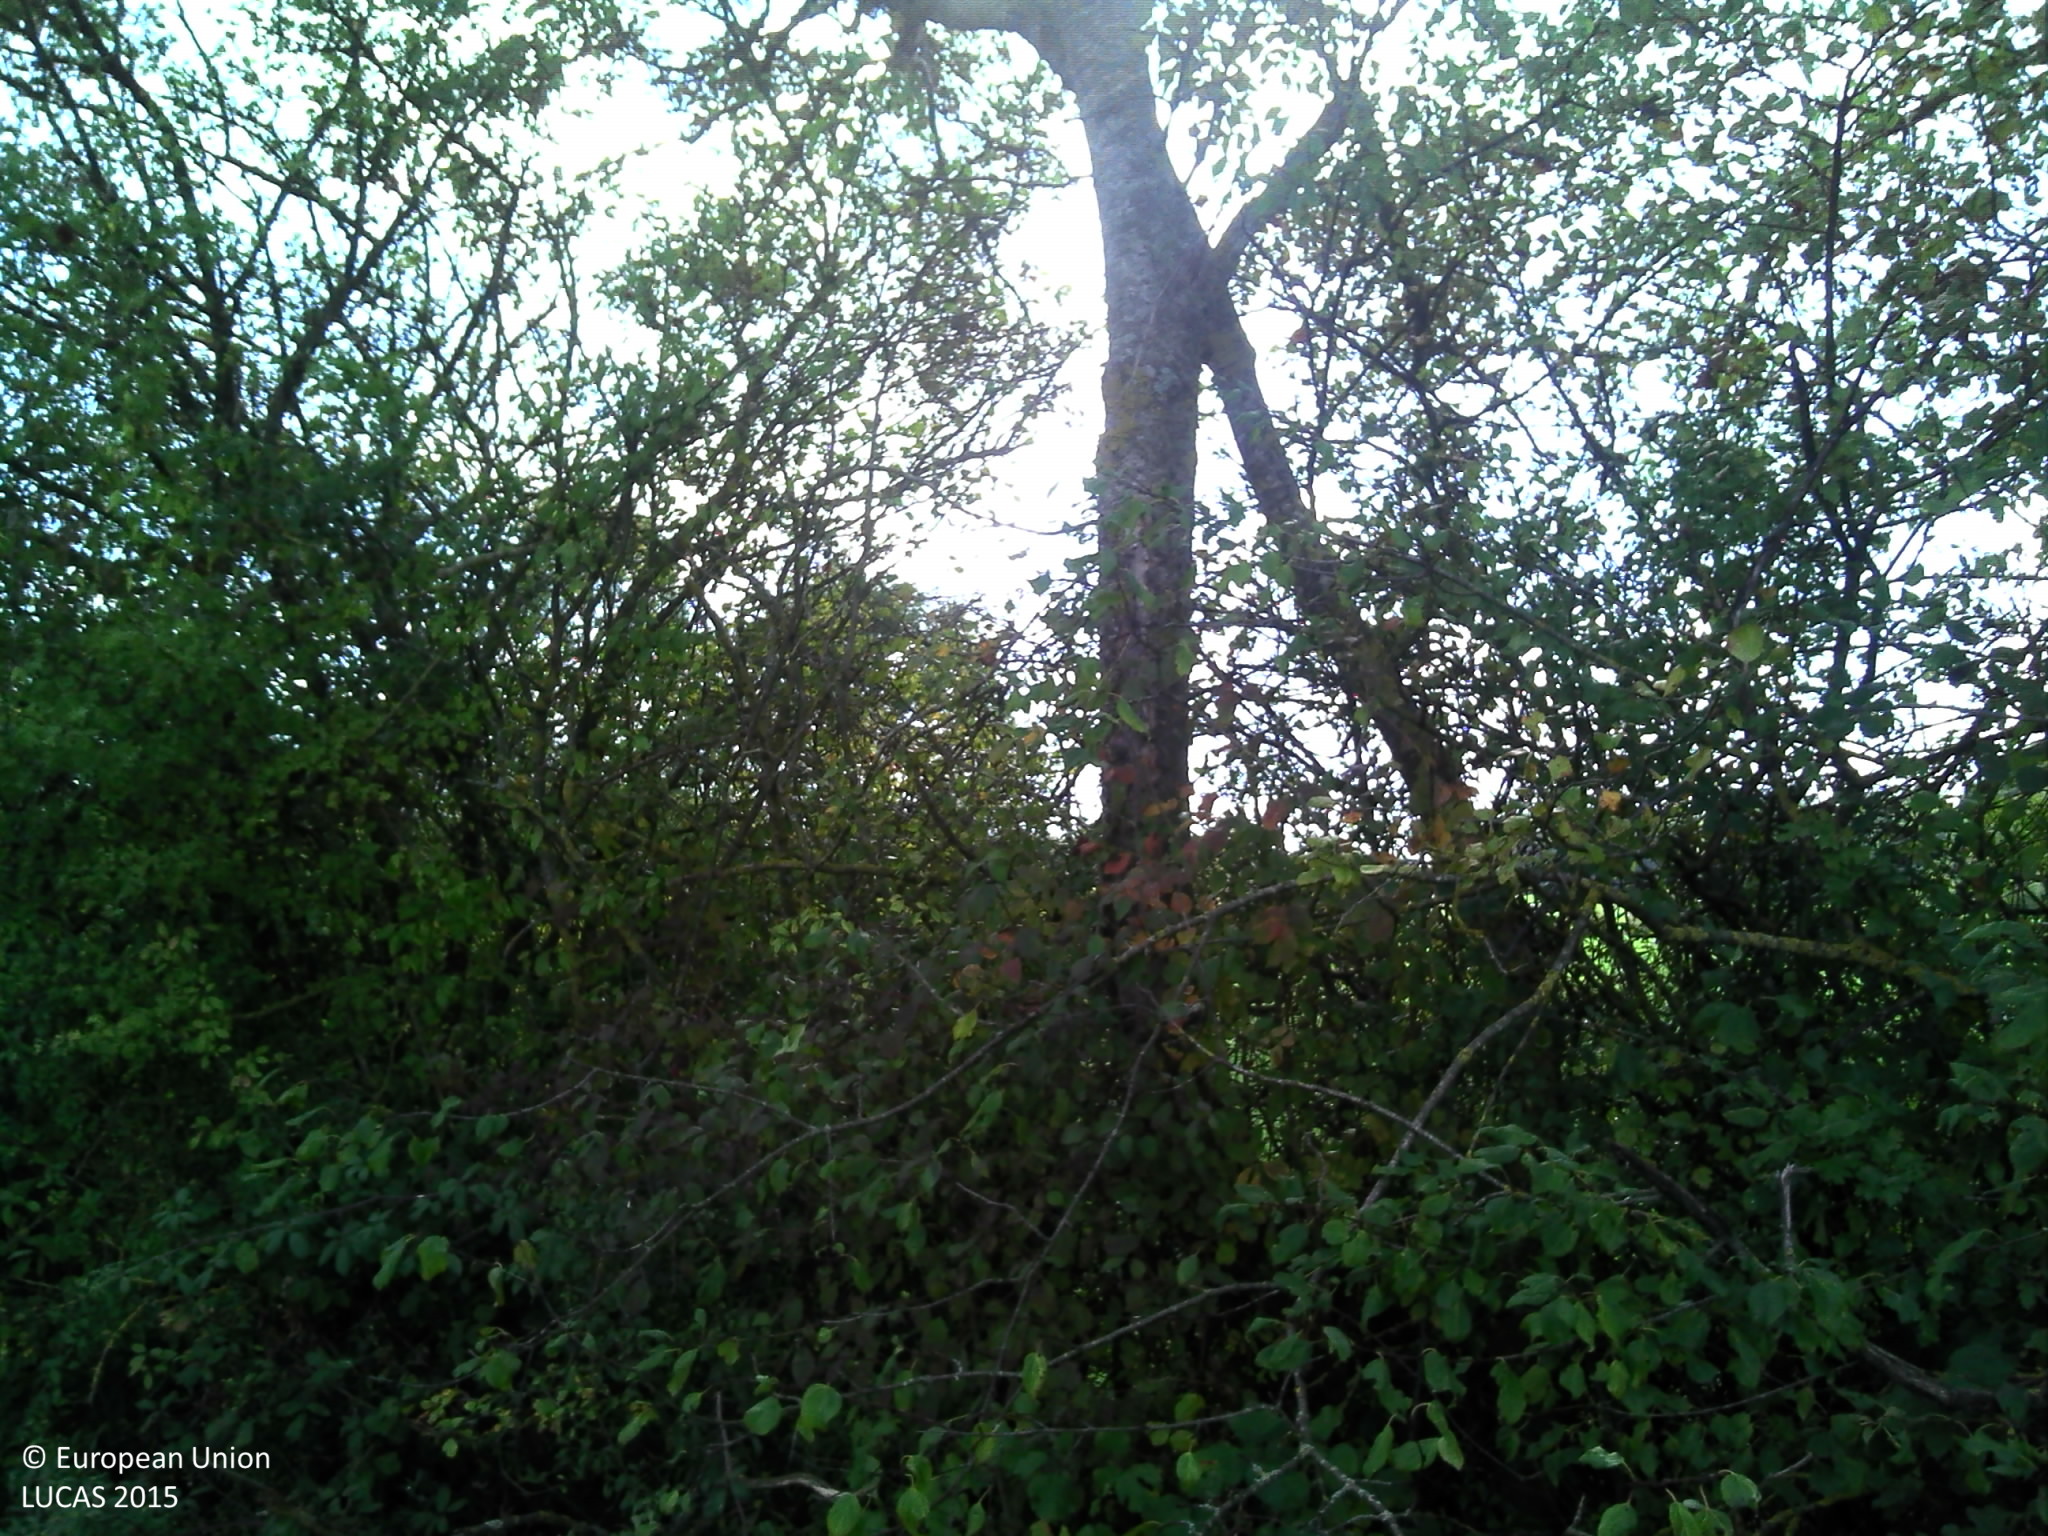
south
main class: Cropland
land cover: Maize
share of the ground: > 75 %
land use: Agriculture (excluding fallow land and kitchen gardens)
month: October
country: FR
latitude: 46.3642
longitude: 5.0763
